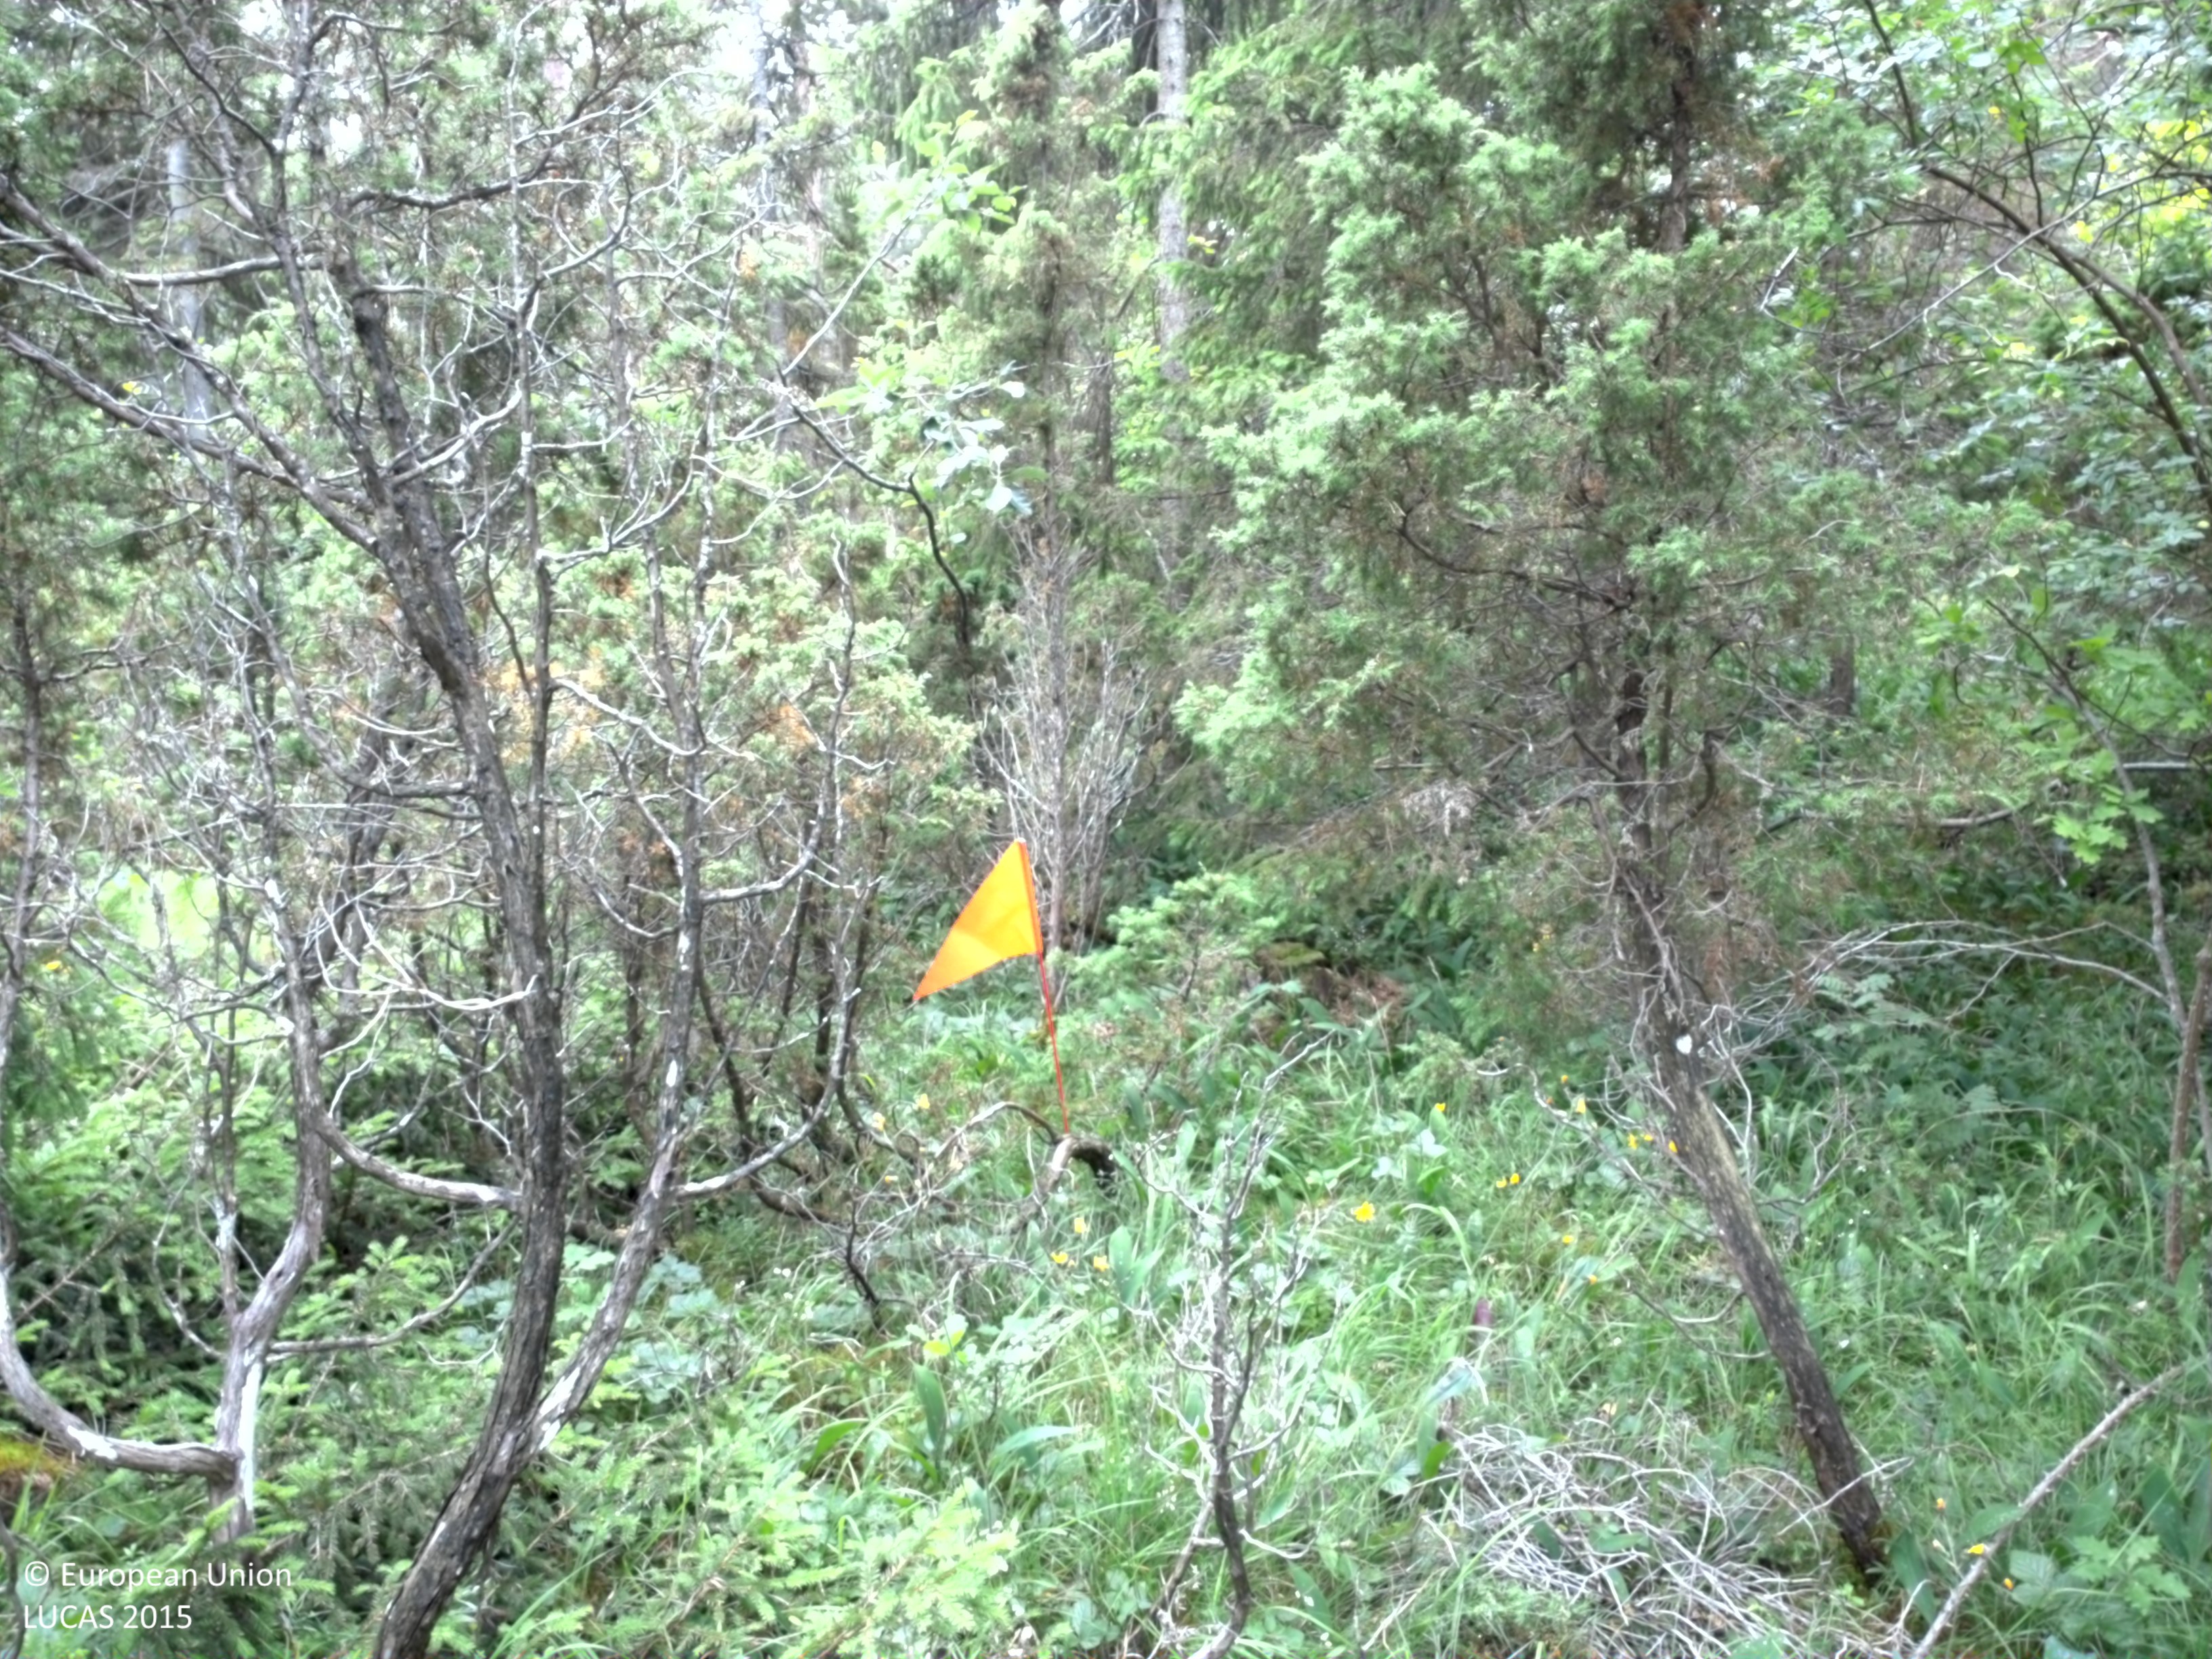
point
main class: Woodland
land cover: Other mixed woodland
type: hemiboreal forest and nemoral coniferous forest and mixed broadleaved-coniferous forest
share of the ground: > 75 %
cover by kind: coniferous forest trees 50 %, broadleaved forest trees 20 %, herbaceous plants 20 %, shrubs 10 %
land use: Forestry
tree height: > 5 m
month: July
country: SE
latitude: 57.3695
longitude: 18.2383
